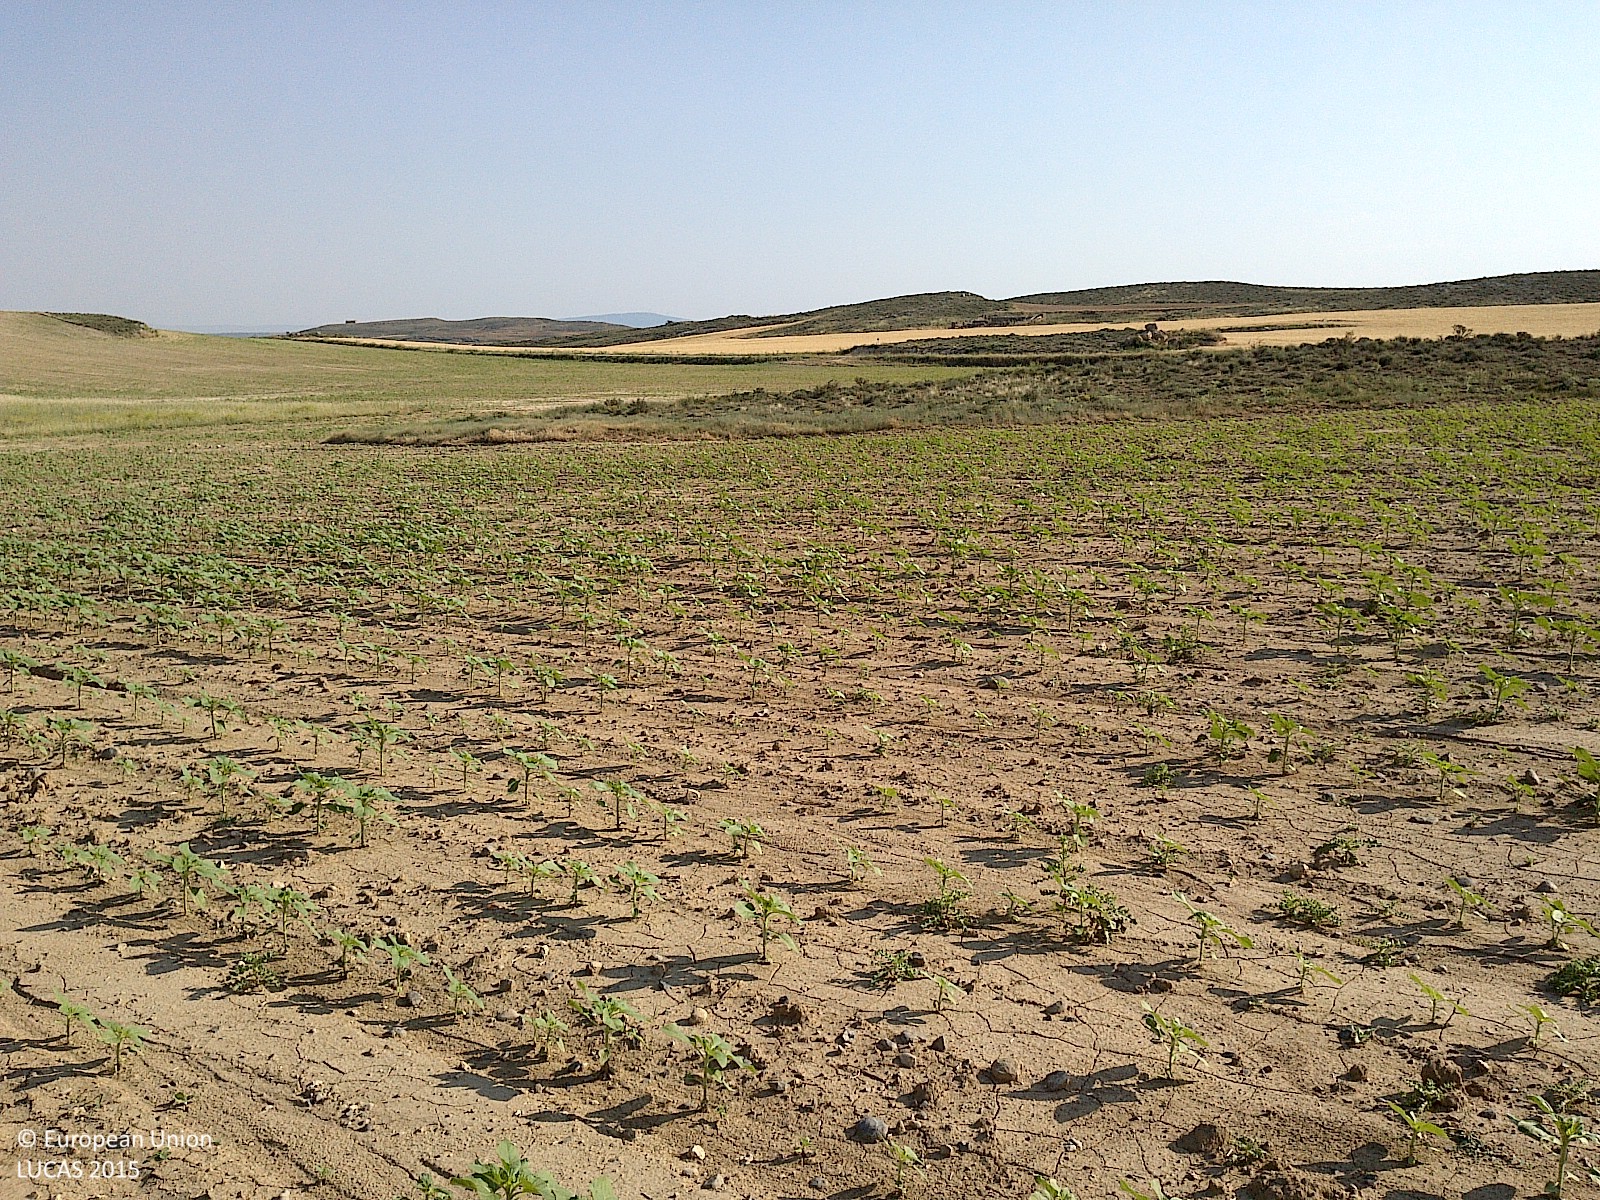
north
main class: Cropland
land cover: Sunflower
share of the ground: < 10 %
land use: Agriculture (excluding fallow land and kitchen gardens)
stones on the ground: < 10 %
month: June
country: ES
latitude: 41.6346
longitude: -2.2426
